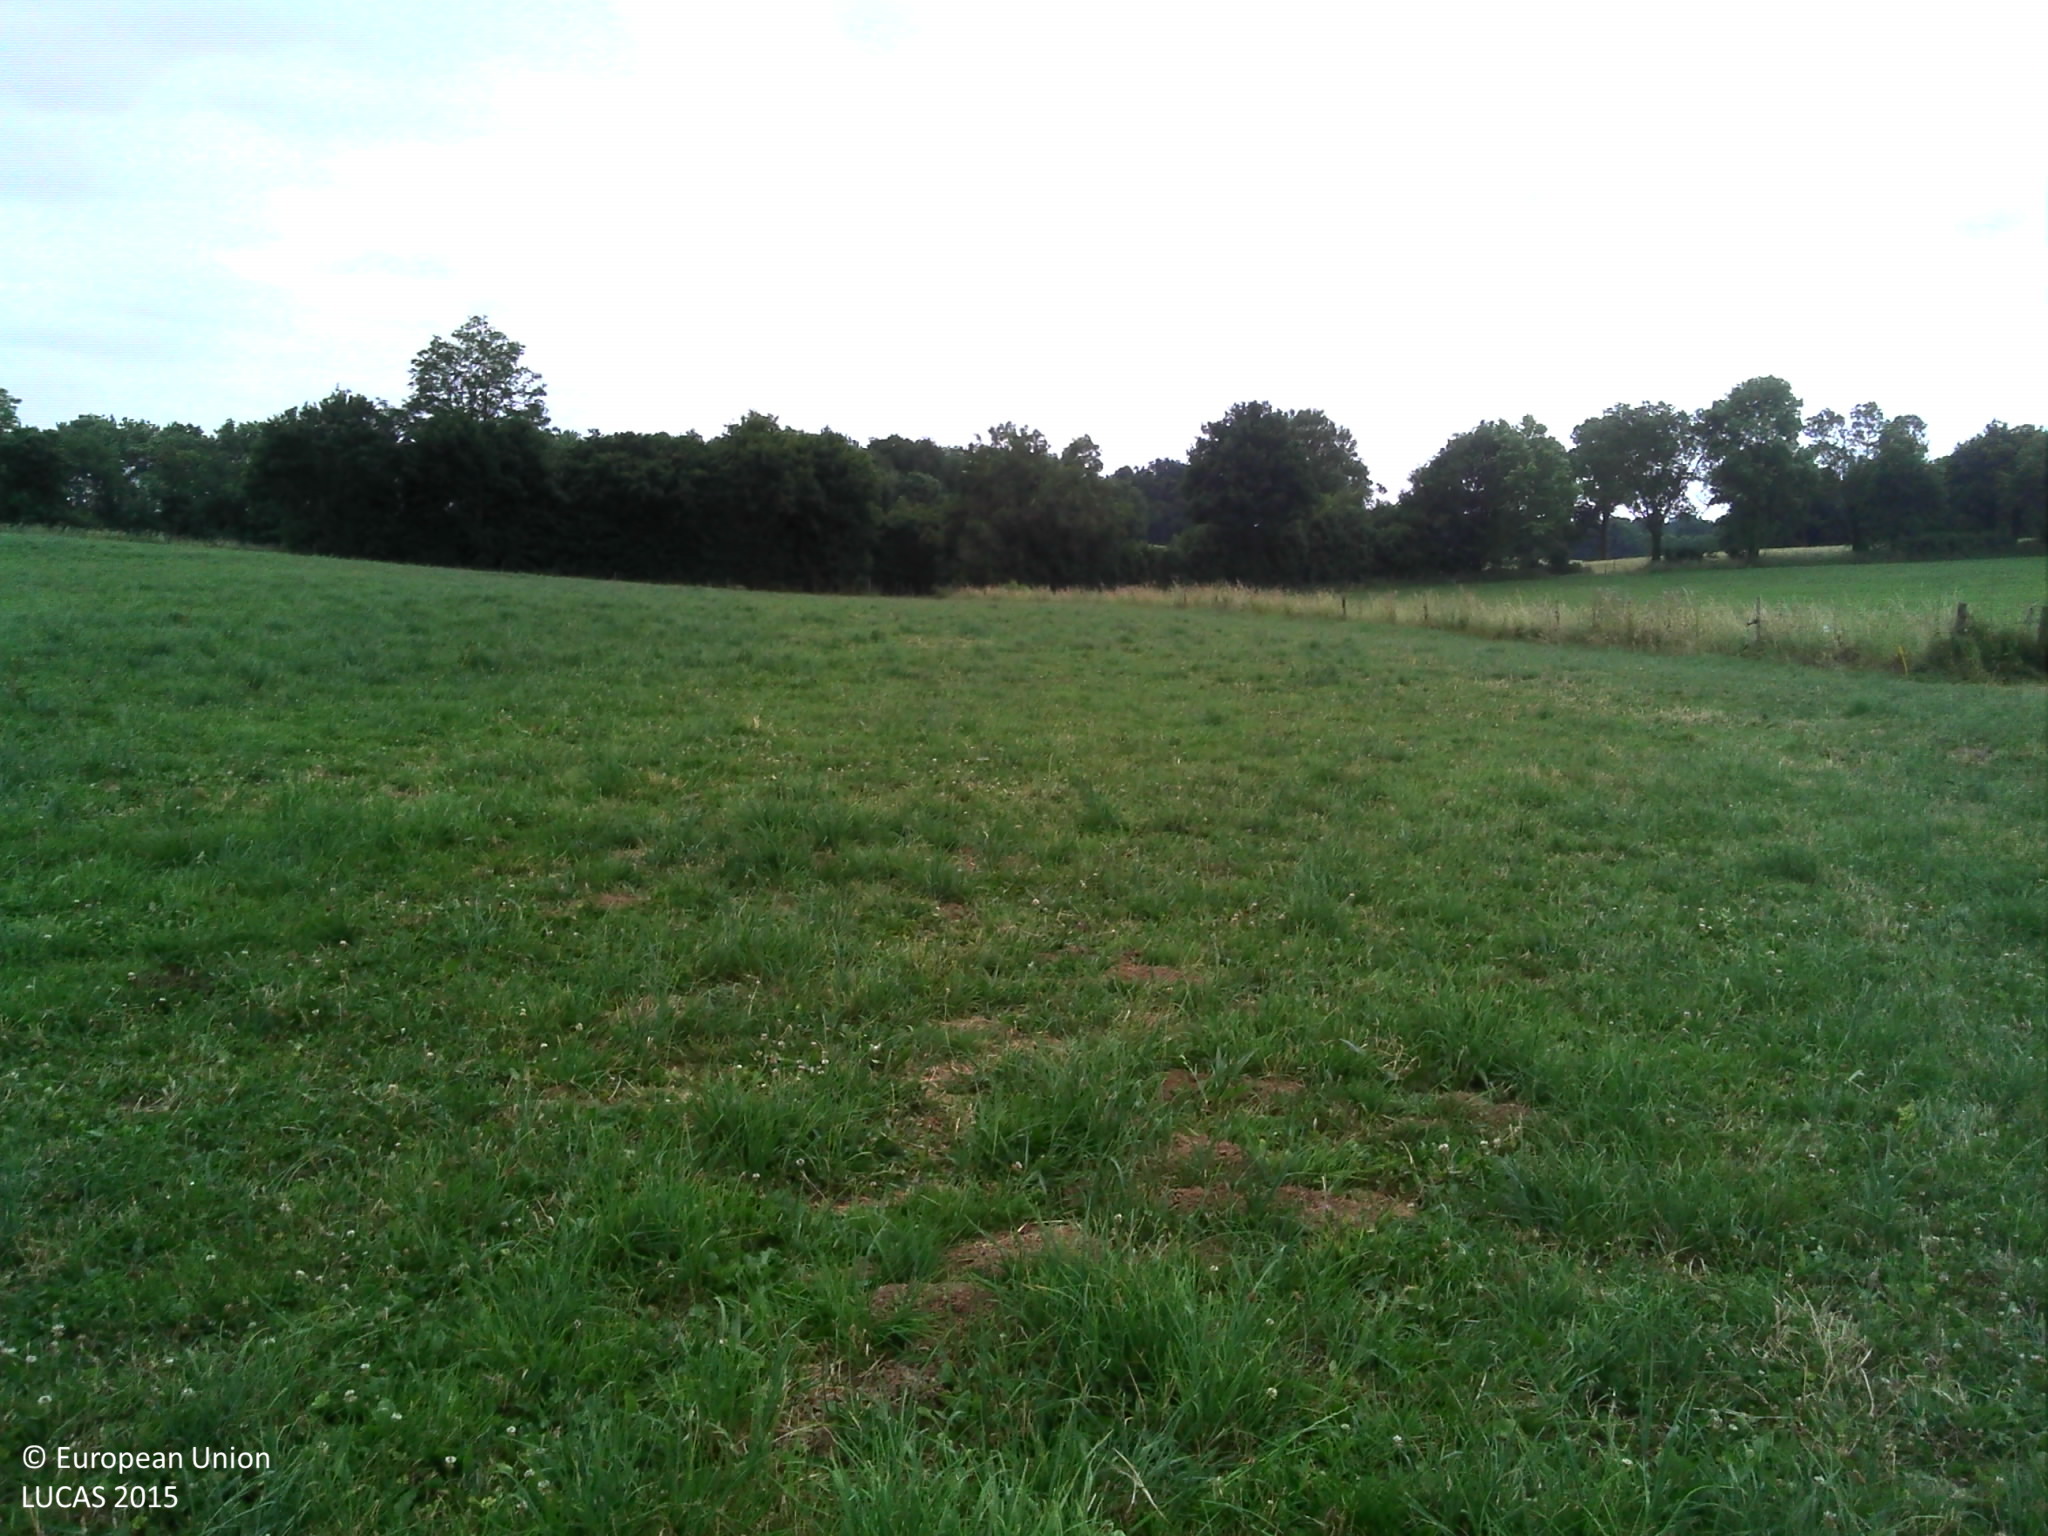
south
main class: Grassland
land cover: Grassland without tree/shrub cover
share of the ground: > 75 %
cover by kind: herbaceous plants 100 %
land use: Agriculture (excluding fallow land and kitchen gardens)
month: June
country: FR
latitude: 46.0837
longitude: 4.8689
